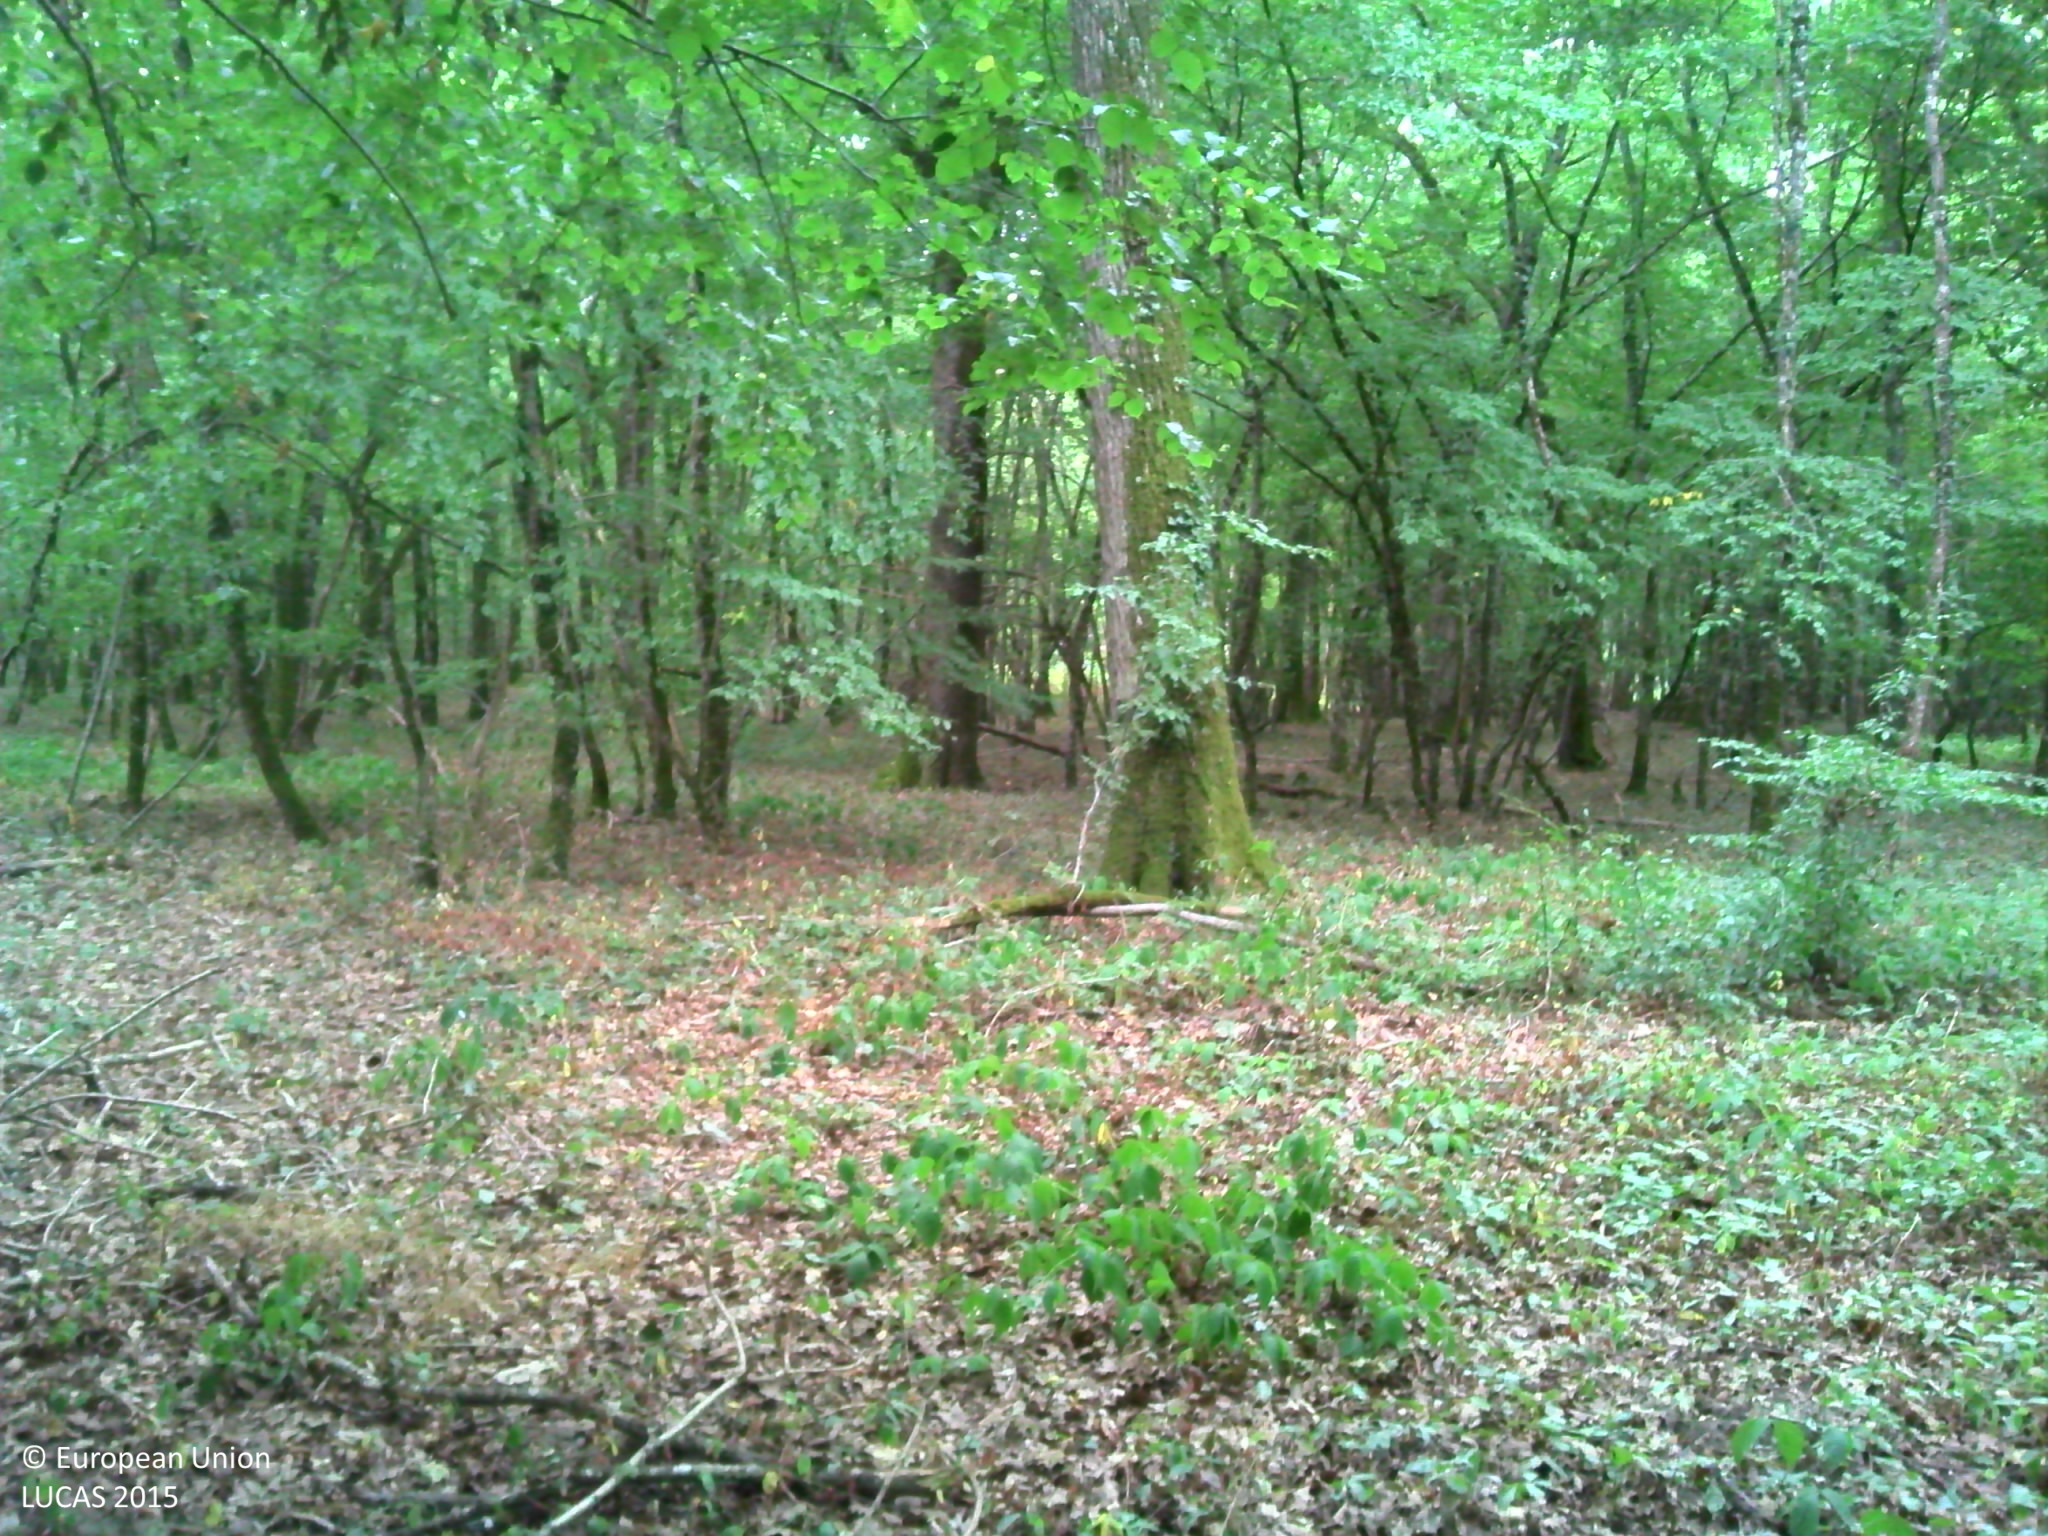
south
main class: Woodland
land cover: Broadleaved woodland
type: mesophytic deciduous forest
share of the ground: > 75 %
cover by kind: broadleaved forest trees 100 %
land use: Forestry
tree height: > 5 m
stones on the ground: < 10 %
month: July
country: FR
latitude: 46.8216
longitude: 2.1408
